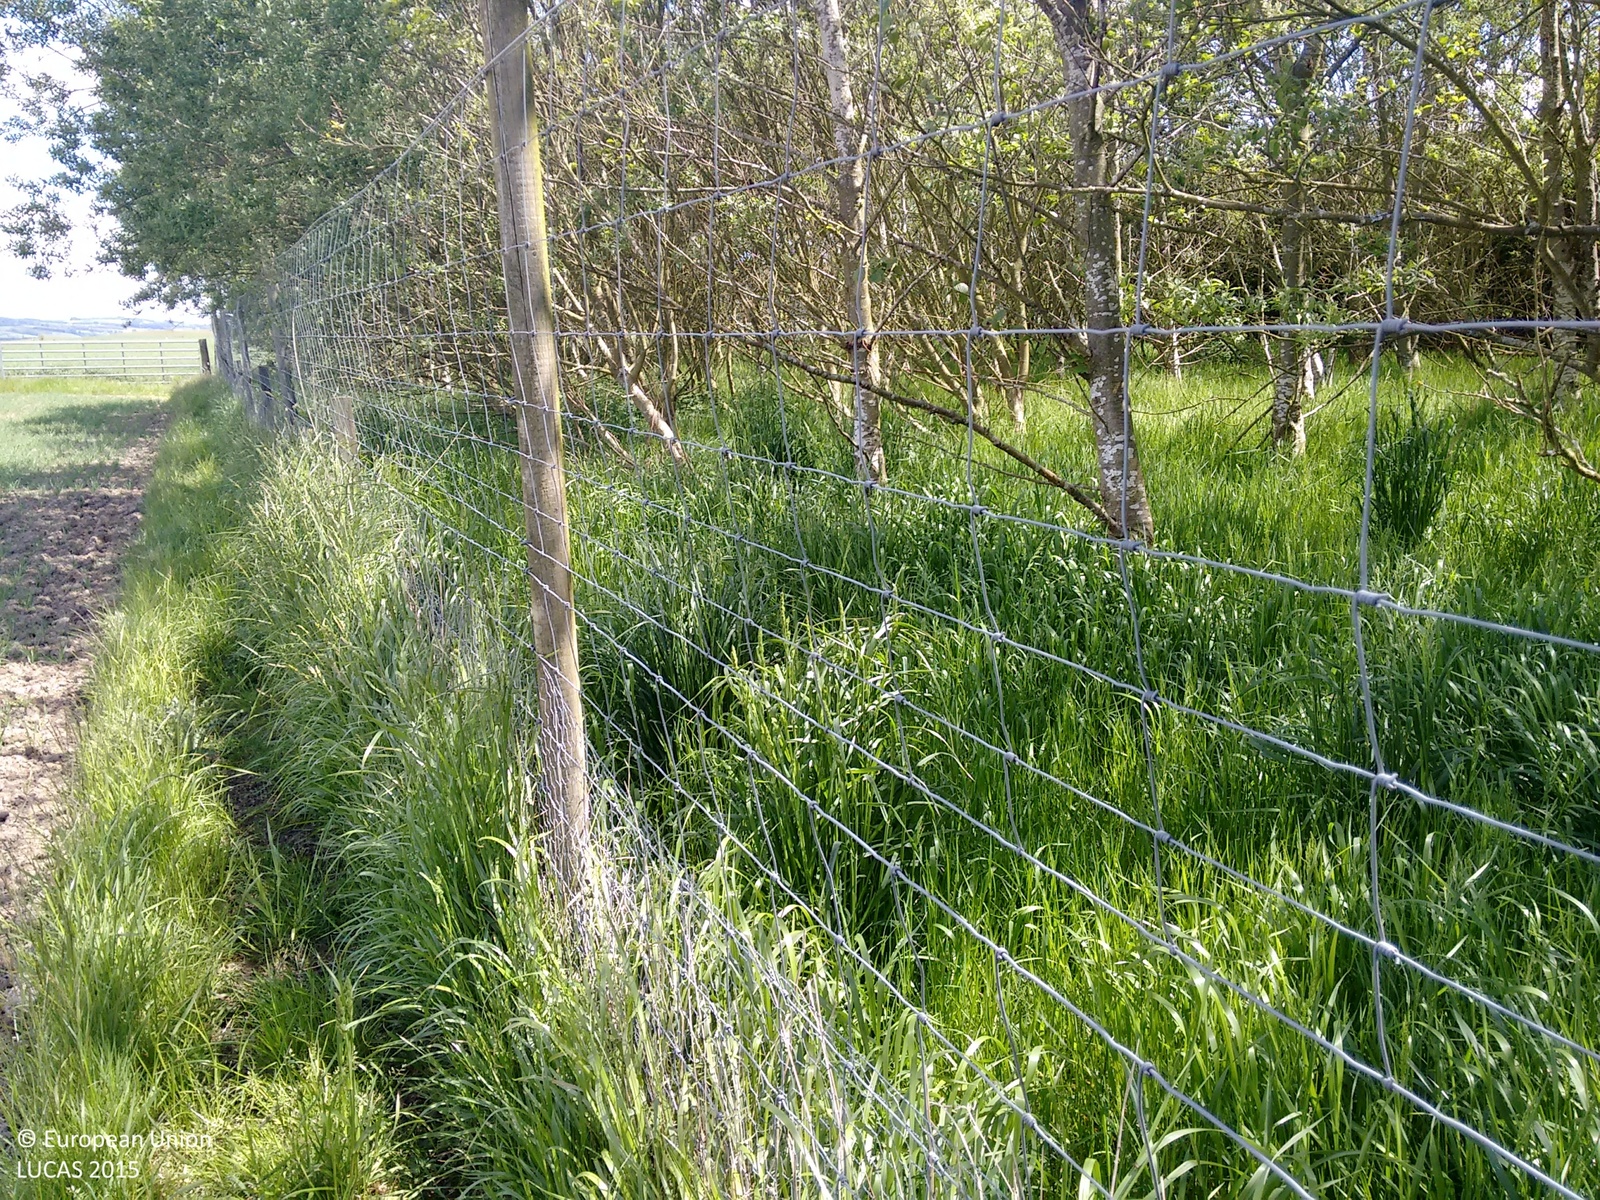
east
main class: Woodland
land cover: Broadleaved woodland
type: exotic forest
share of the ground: > 75 %
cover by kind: broadleaved forest trees 100 %
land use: Forestry
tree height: < 5 m
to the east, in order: Broadleaved woodland; Spruce dominated coniferous woodland; Fences; Grass margins; Barley; Grassland without tree/shrub cover; Rivers and streams; Grass margins; Fences; Grass margins; Barley
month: June
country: GB
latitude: 56.1749
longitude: -3.3955
